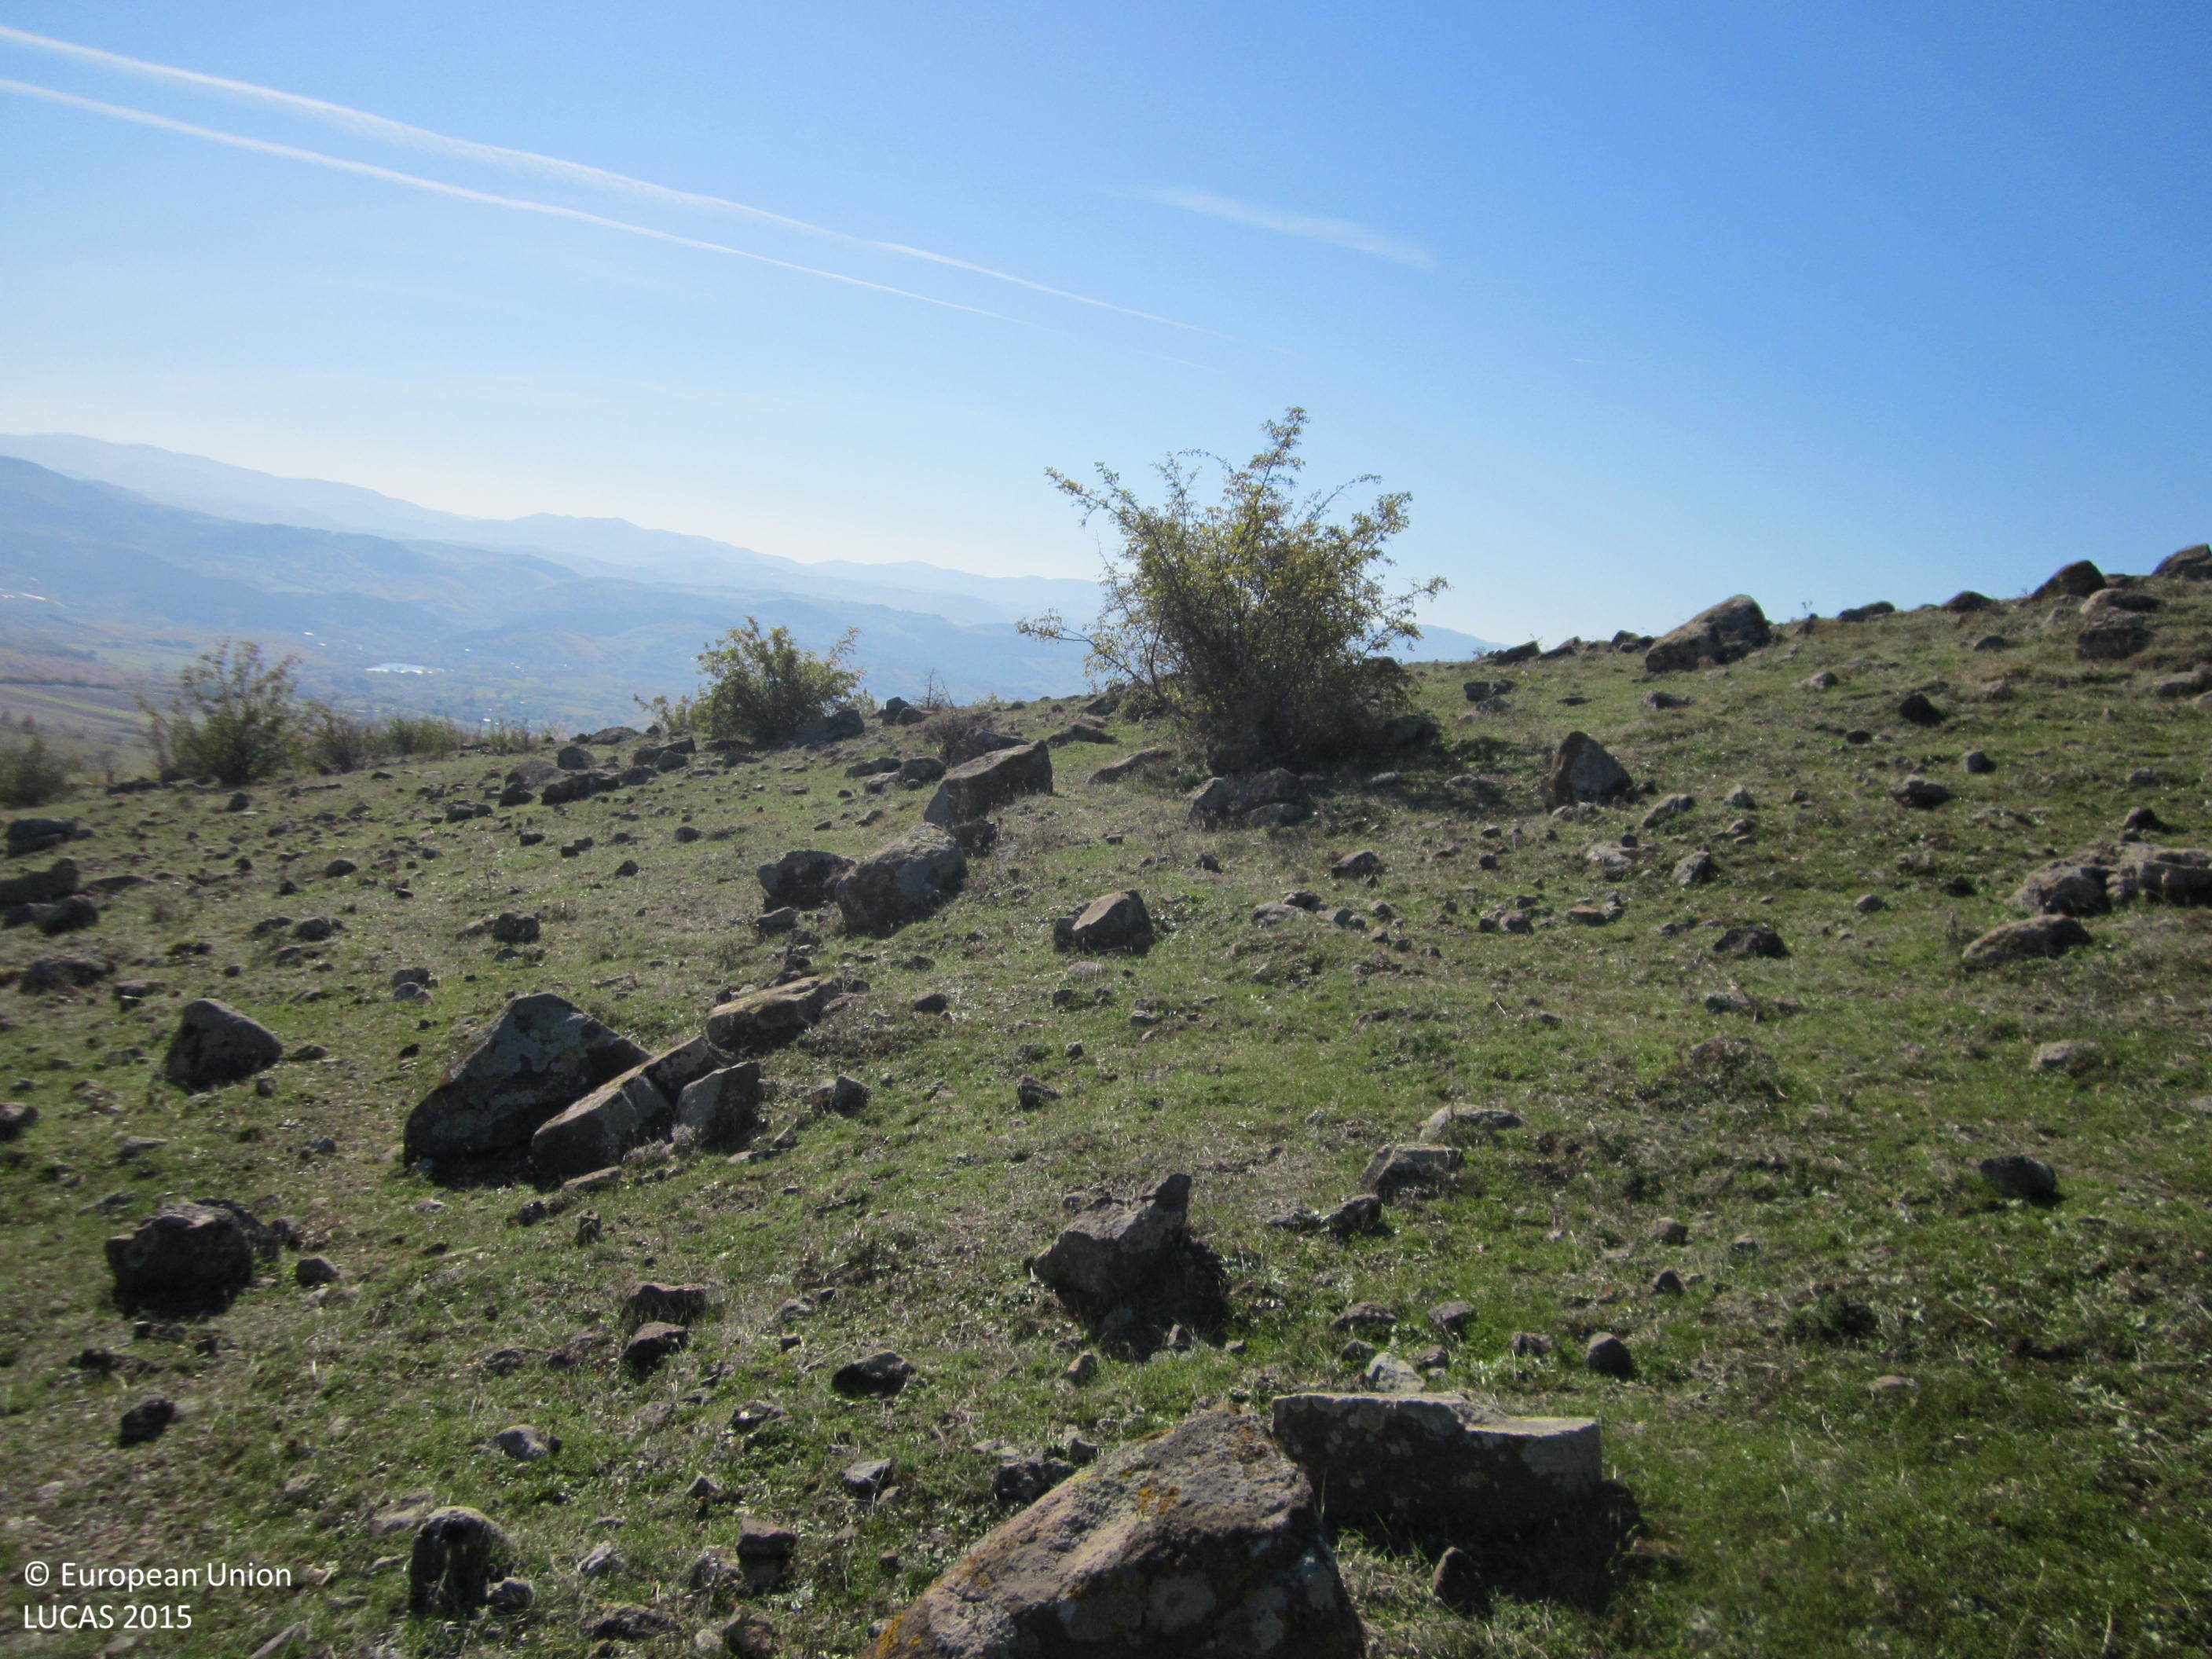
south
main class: Grassland
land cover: Grassland with sparse tree/shrub cover
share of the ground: > 75 %
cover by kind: herbaceous plants 70 %, unconsolidated bare surface 20 %, broadleaved forest trees 5 %, shrubs 5 %
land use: Semi-natural and natural areas not in use
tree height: < 5 m
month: November
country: BG
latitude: 41.4739
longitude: 25.7123
